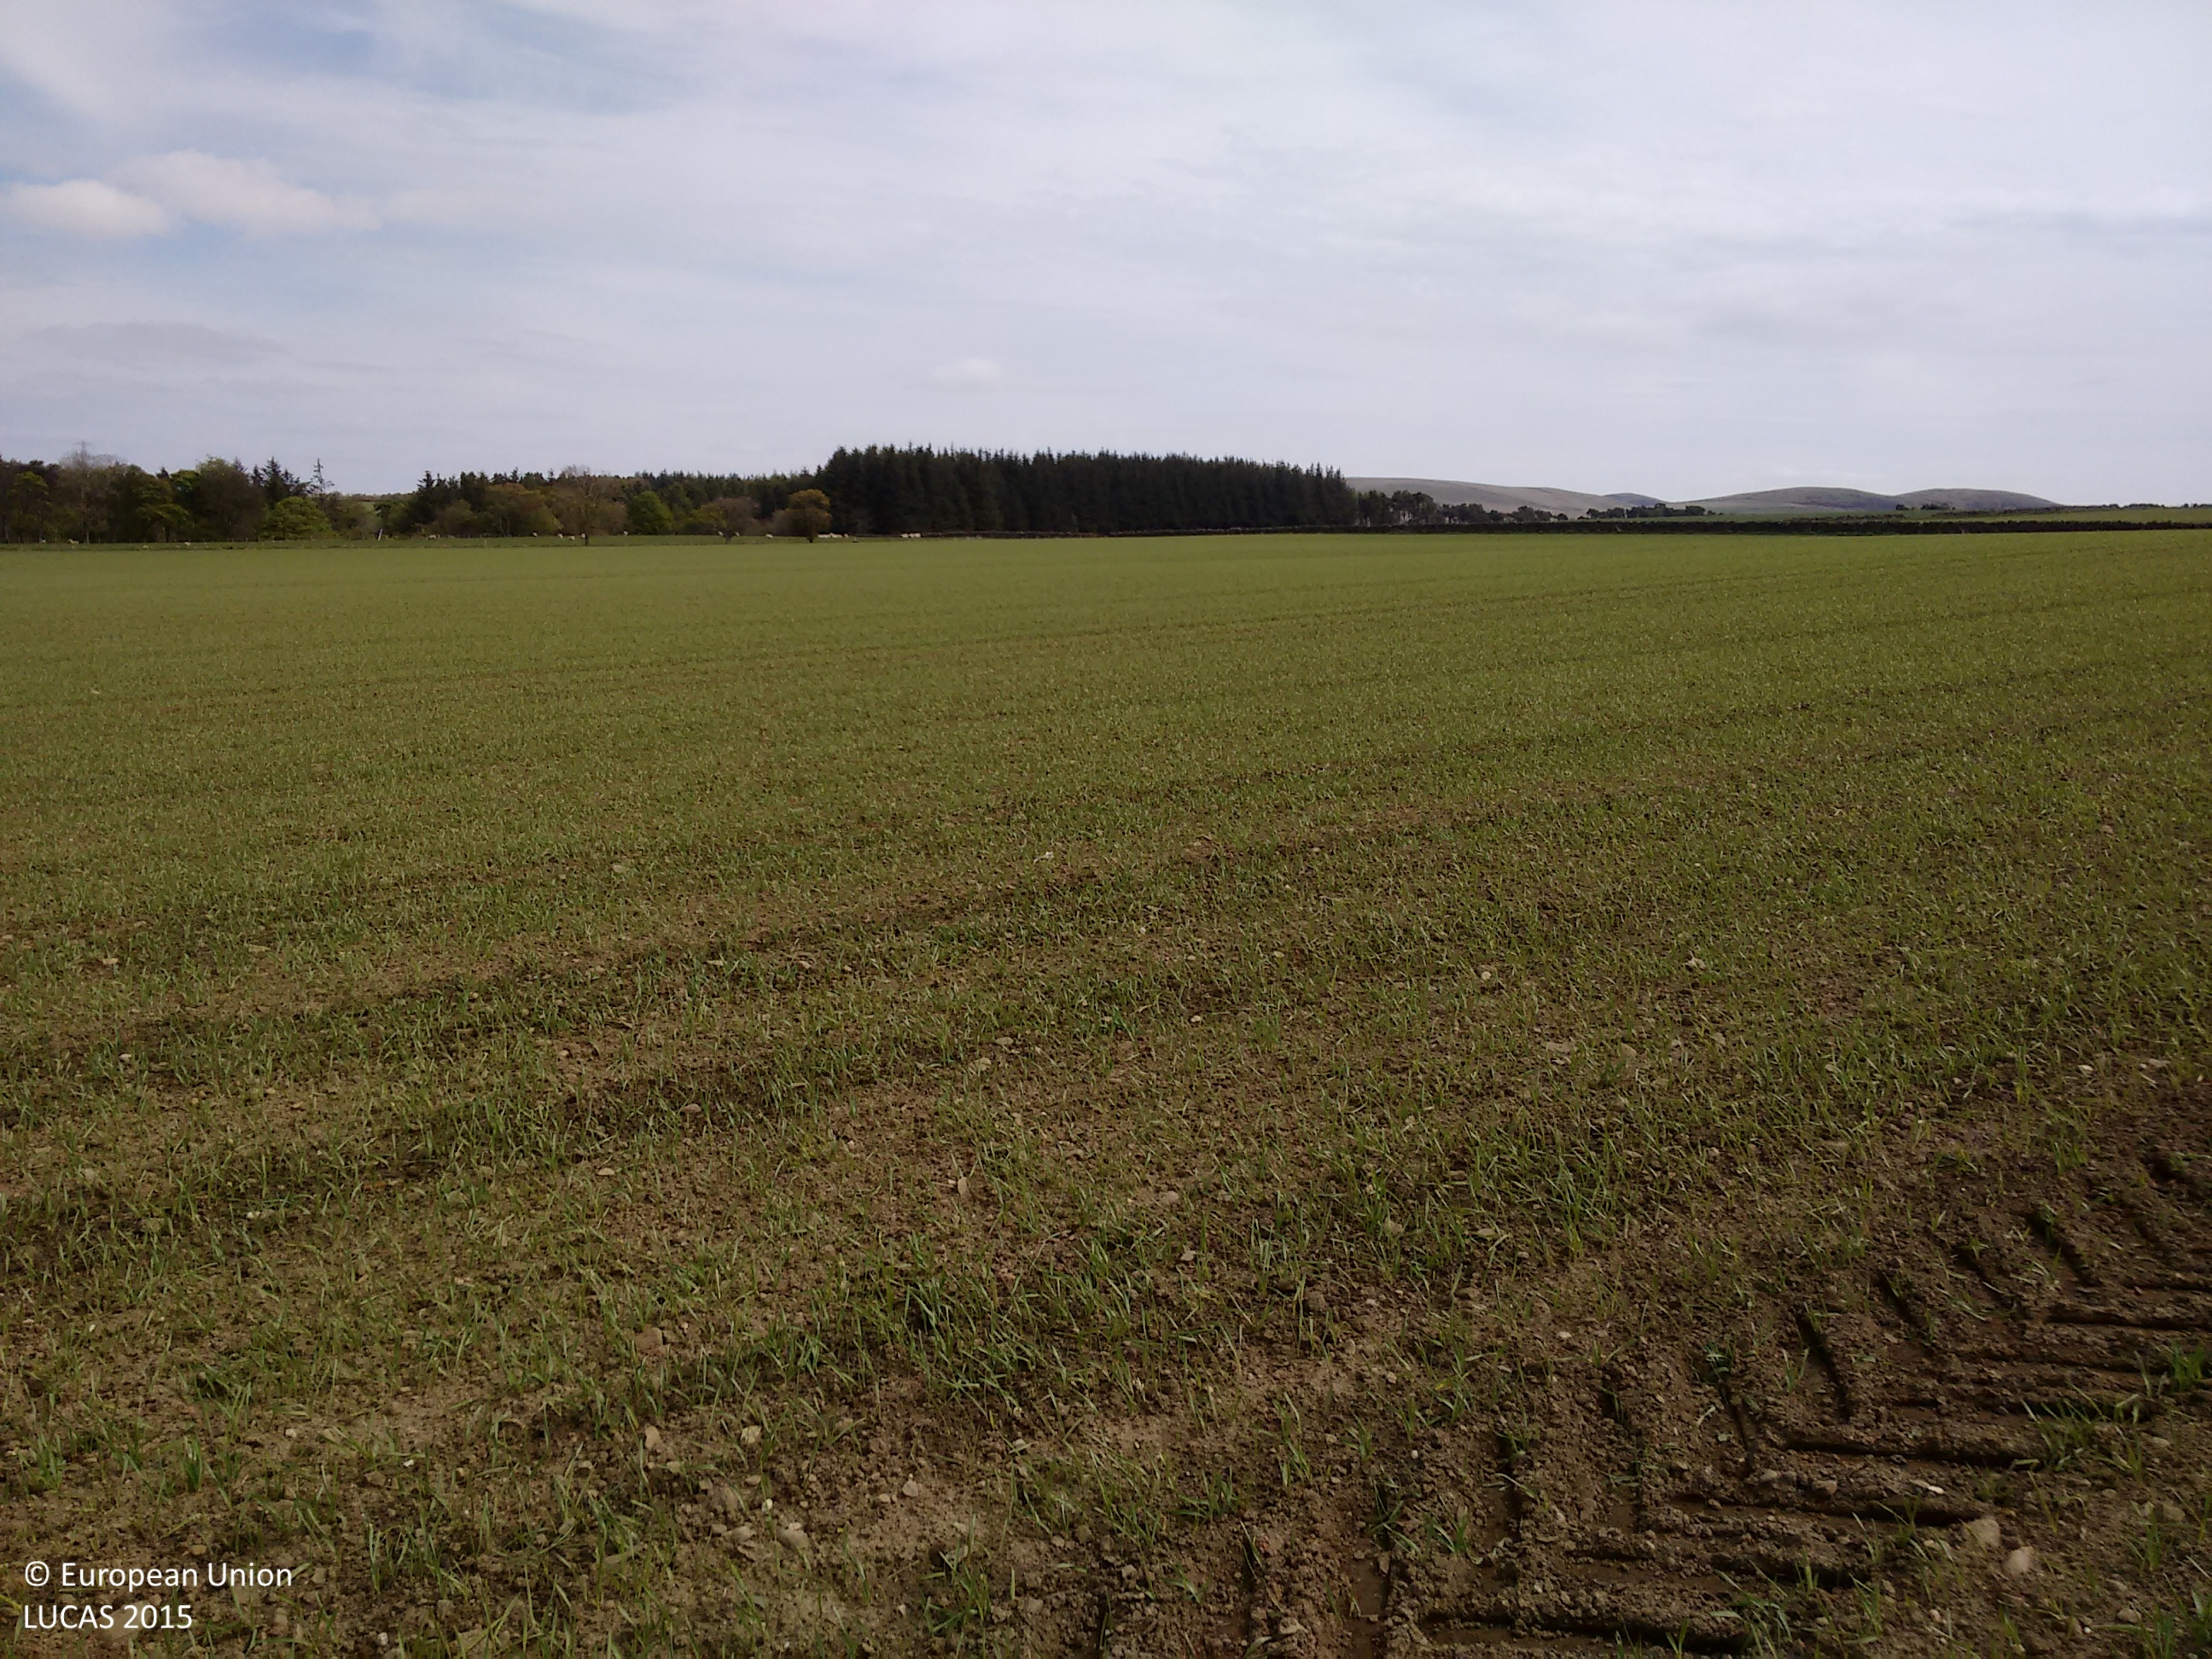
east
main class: Cropland
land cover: Barley
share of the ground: 10 - 25 %
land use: Agriculture (excluding fallow land and kitchen gardens)
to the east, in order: Barley; Grass margins; Dry stone walls; Grassland without tree/shrub cover; Barley
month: May
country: GB
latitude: 55.8721
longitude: -3.3233
